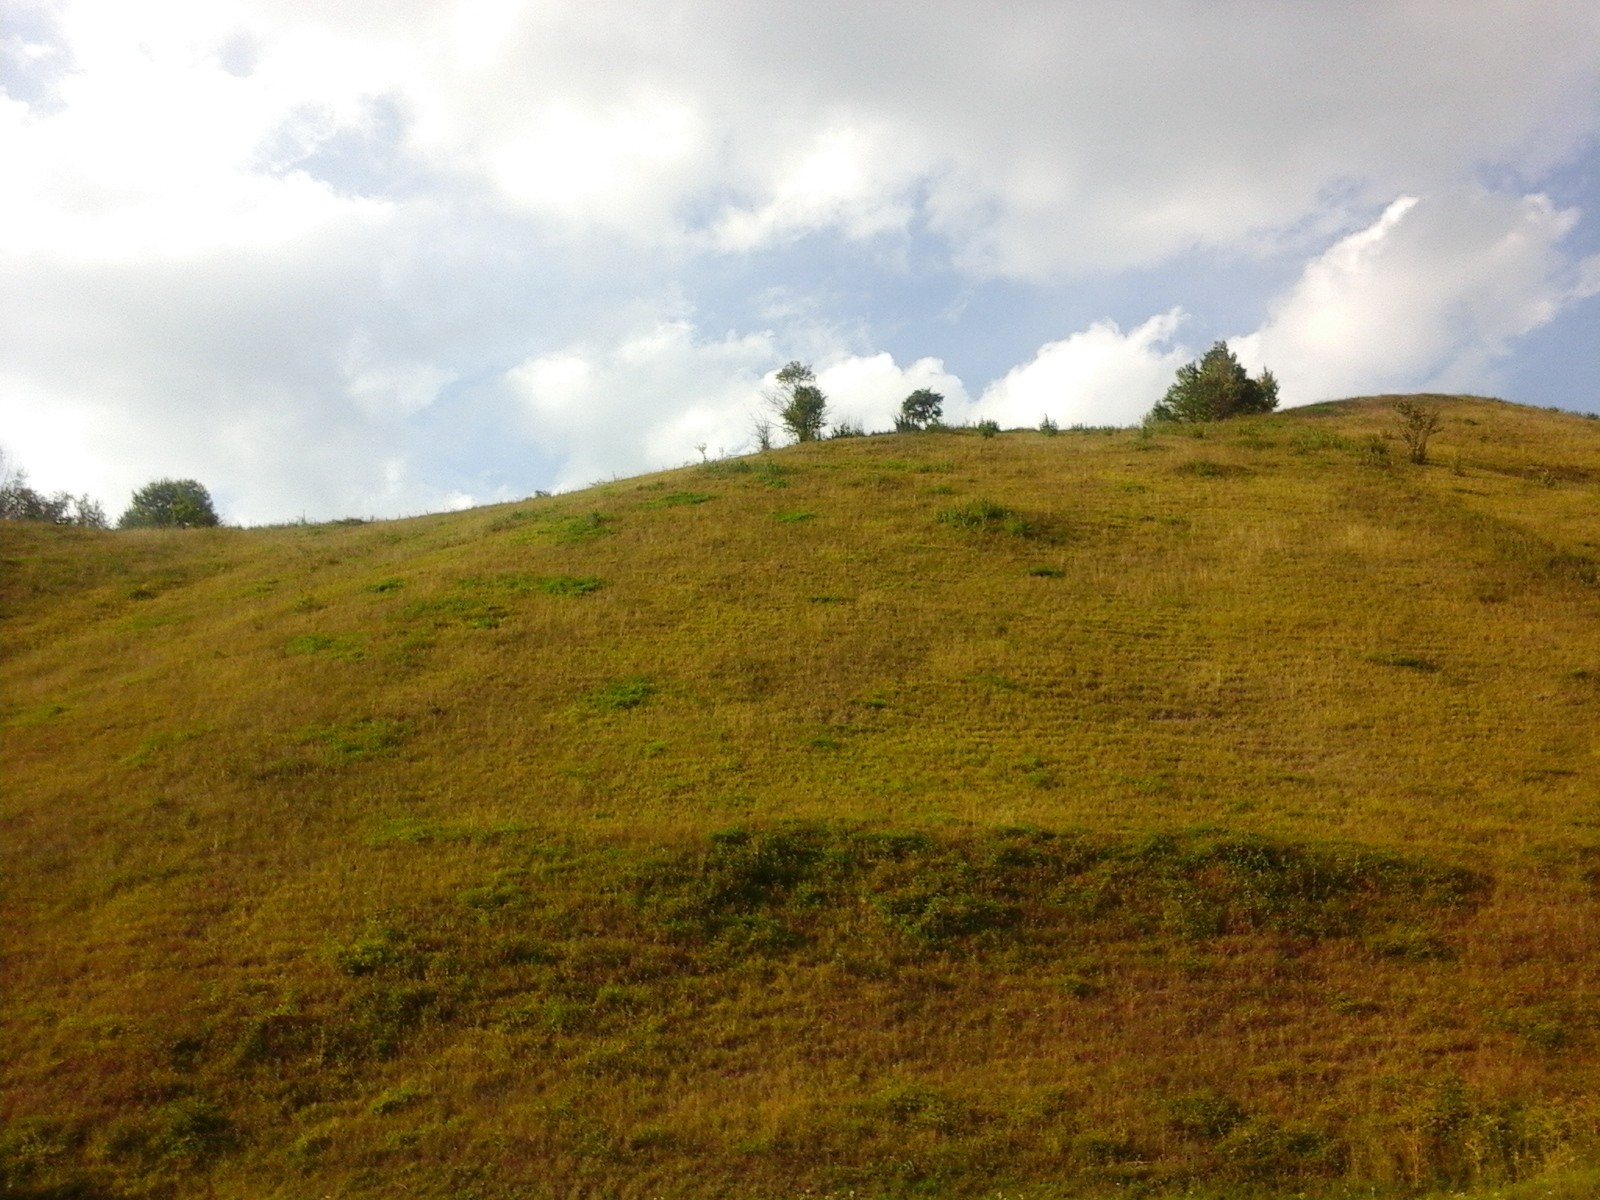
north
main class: Grassland
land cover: Grassland with sparse tree/shrub cover
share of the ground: > 75 %
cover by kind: herbaceous plants 95 %, broadleaved forest trees 5 %
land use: Agriculture (excluding fallow land and kitchen gardens)
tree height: > 5 m
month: September
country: RO
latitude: 47.7497
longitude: 24.2416
